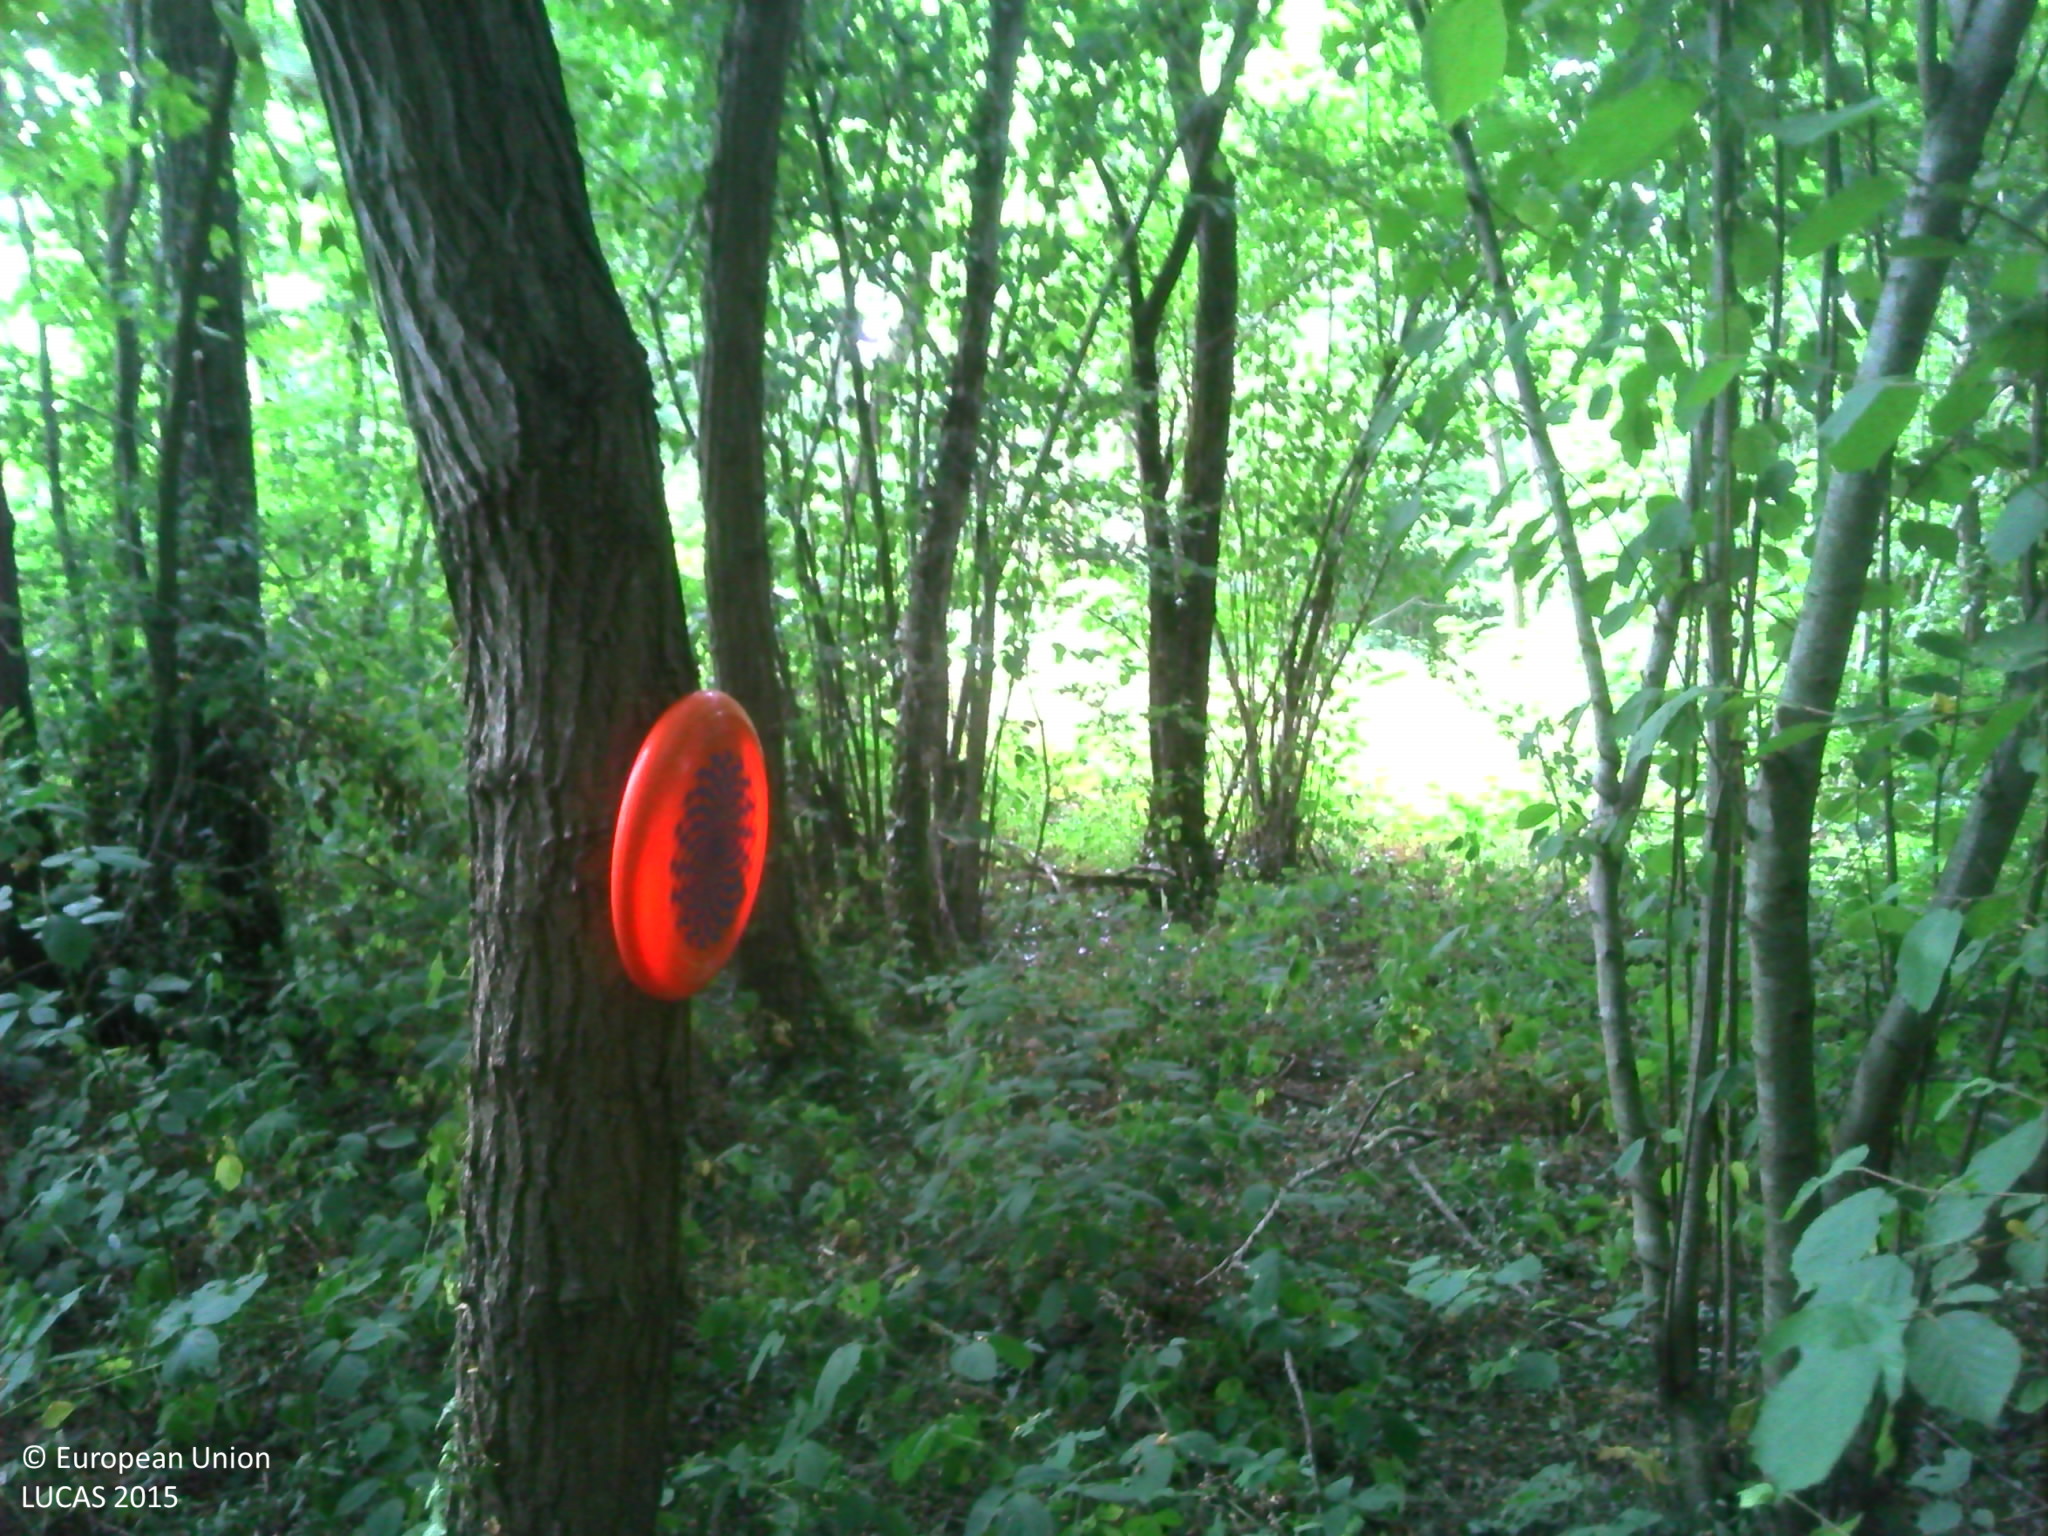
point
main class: Woodland
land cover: Broadleaved woodland
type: mesophytic deciduous forest
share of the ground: > 75 %
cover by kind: broadleaved forest trees 85 %, herbaceous plants 10 %, shrubs 5 %
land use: Forestry
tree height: > 5 m
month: July
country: FR
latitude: 46.8348
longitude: 5.1112
